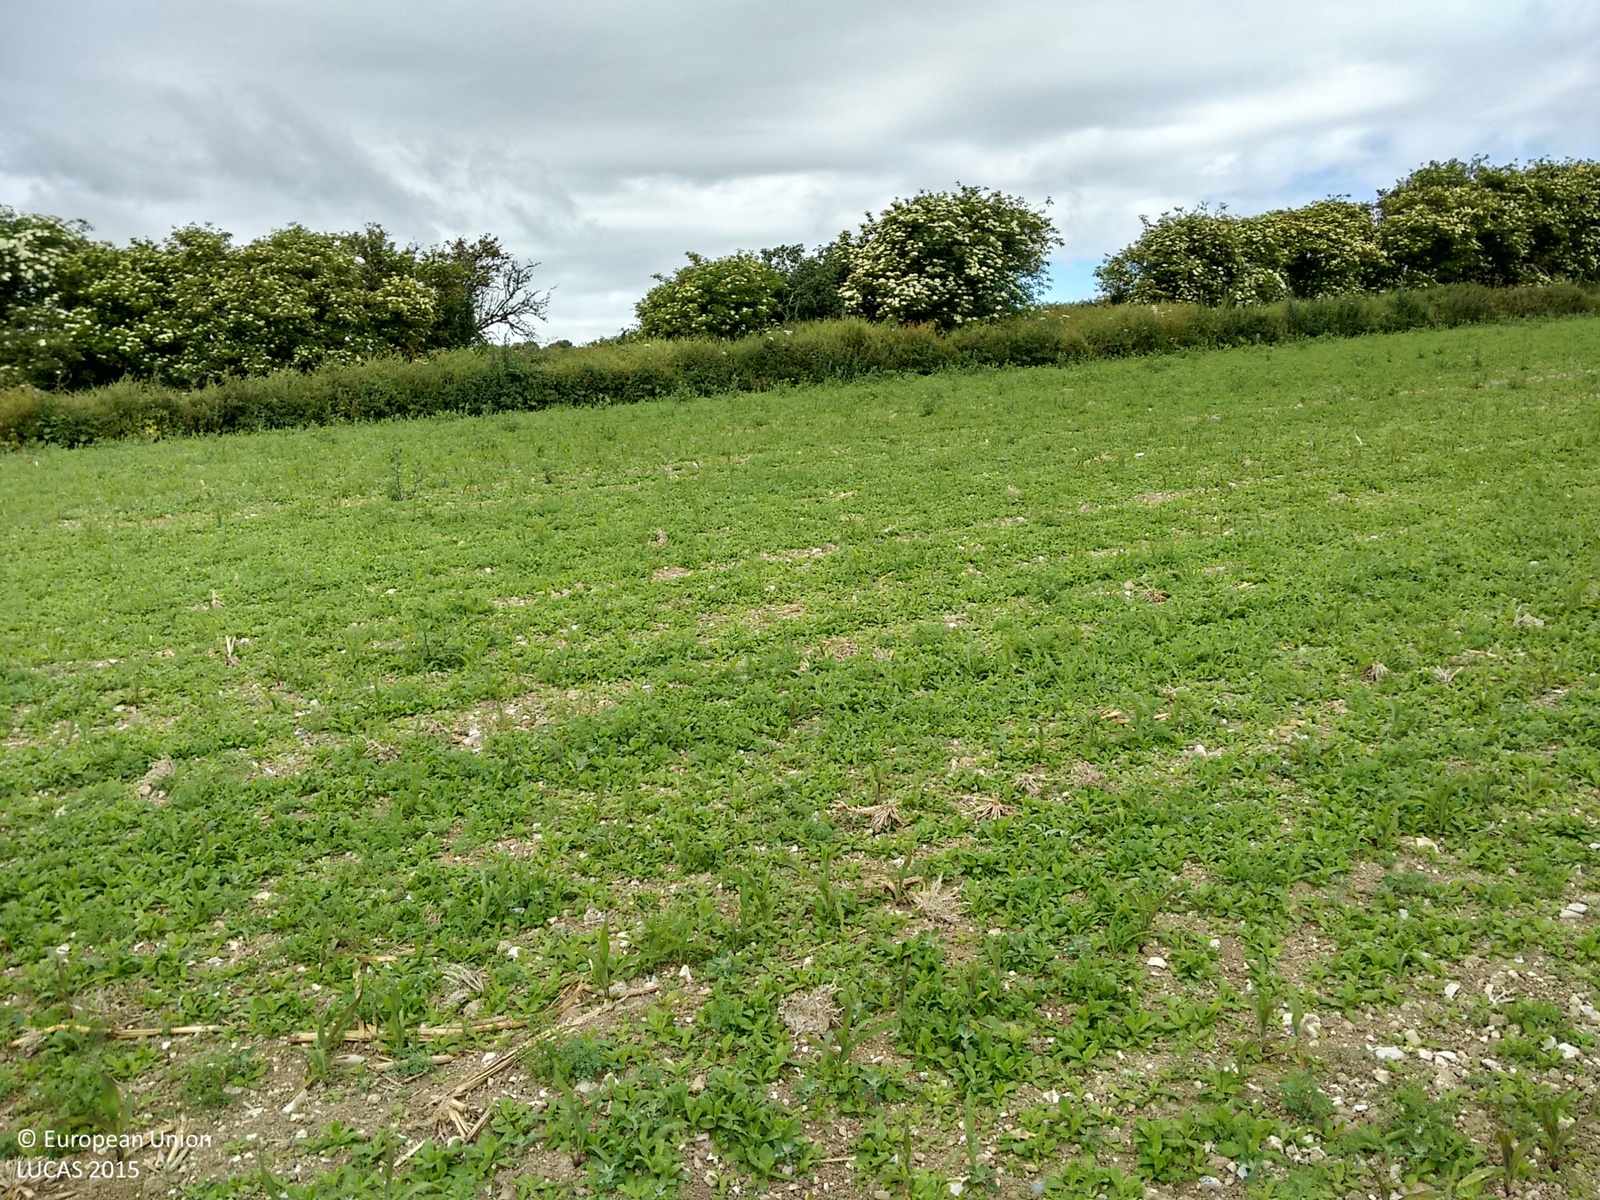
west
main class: Cropland
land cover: Maize
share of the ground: 10 - 25 %
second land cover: Spontaneously vegetated surfaces
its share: > 75 %
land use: Agriculture (excluding fallow land and kitchen gardens)
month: June
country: GB
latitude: 51.5200
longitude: -1.1873
